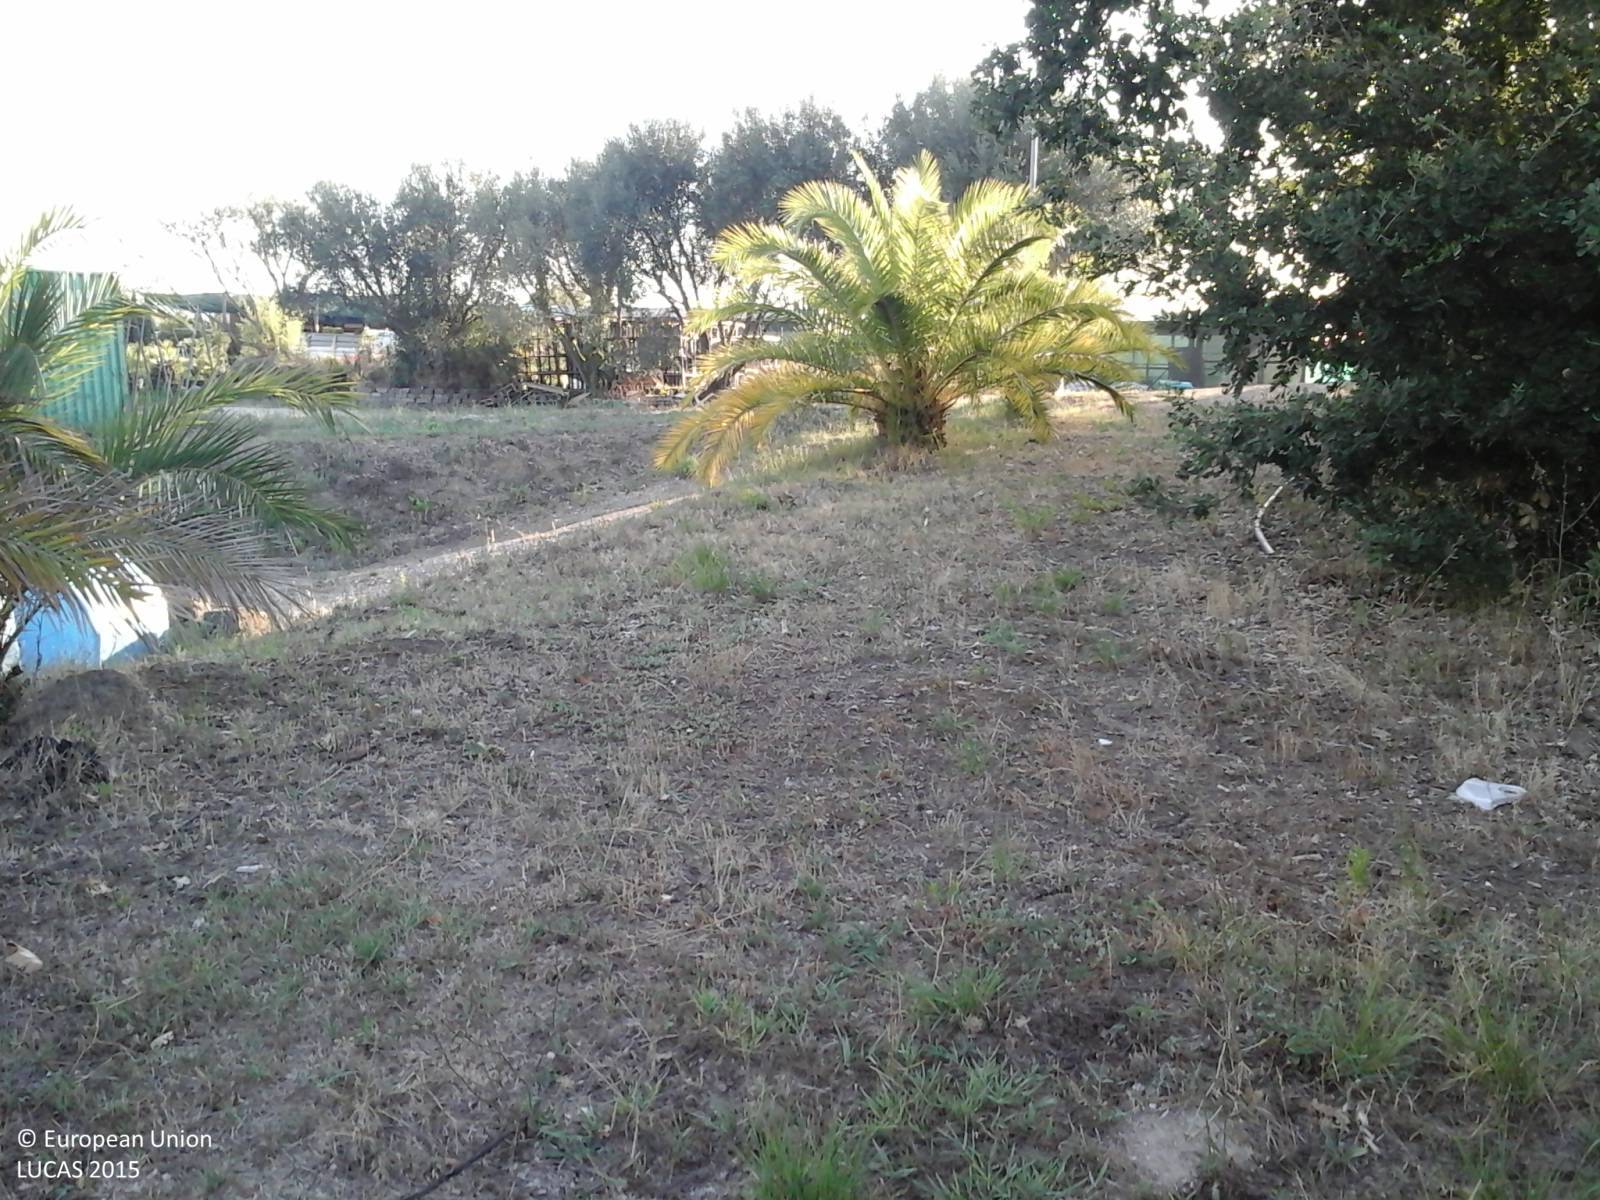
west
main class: Grassland
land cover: Grassland without tree/shrub cover
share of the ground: > 75 %
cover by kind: herbaceous plants 100 %
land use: Agriculture (excluding fallow land and kitchen gardens)
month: July
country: IT
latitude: 42.0660
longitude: 12.3722
